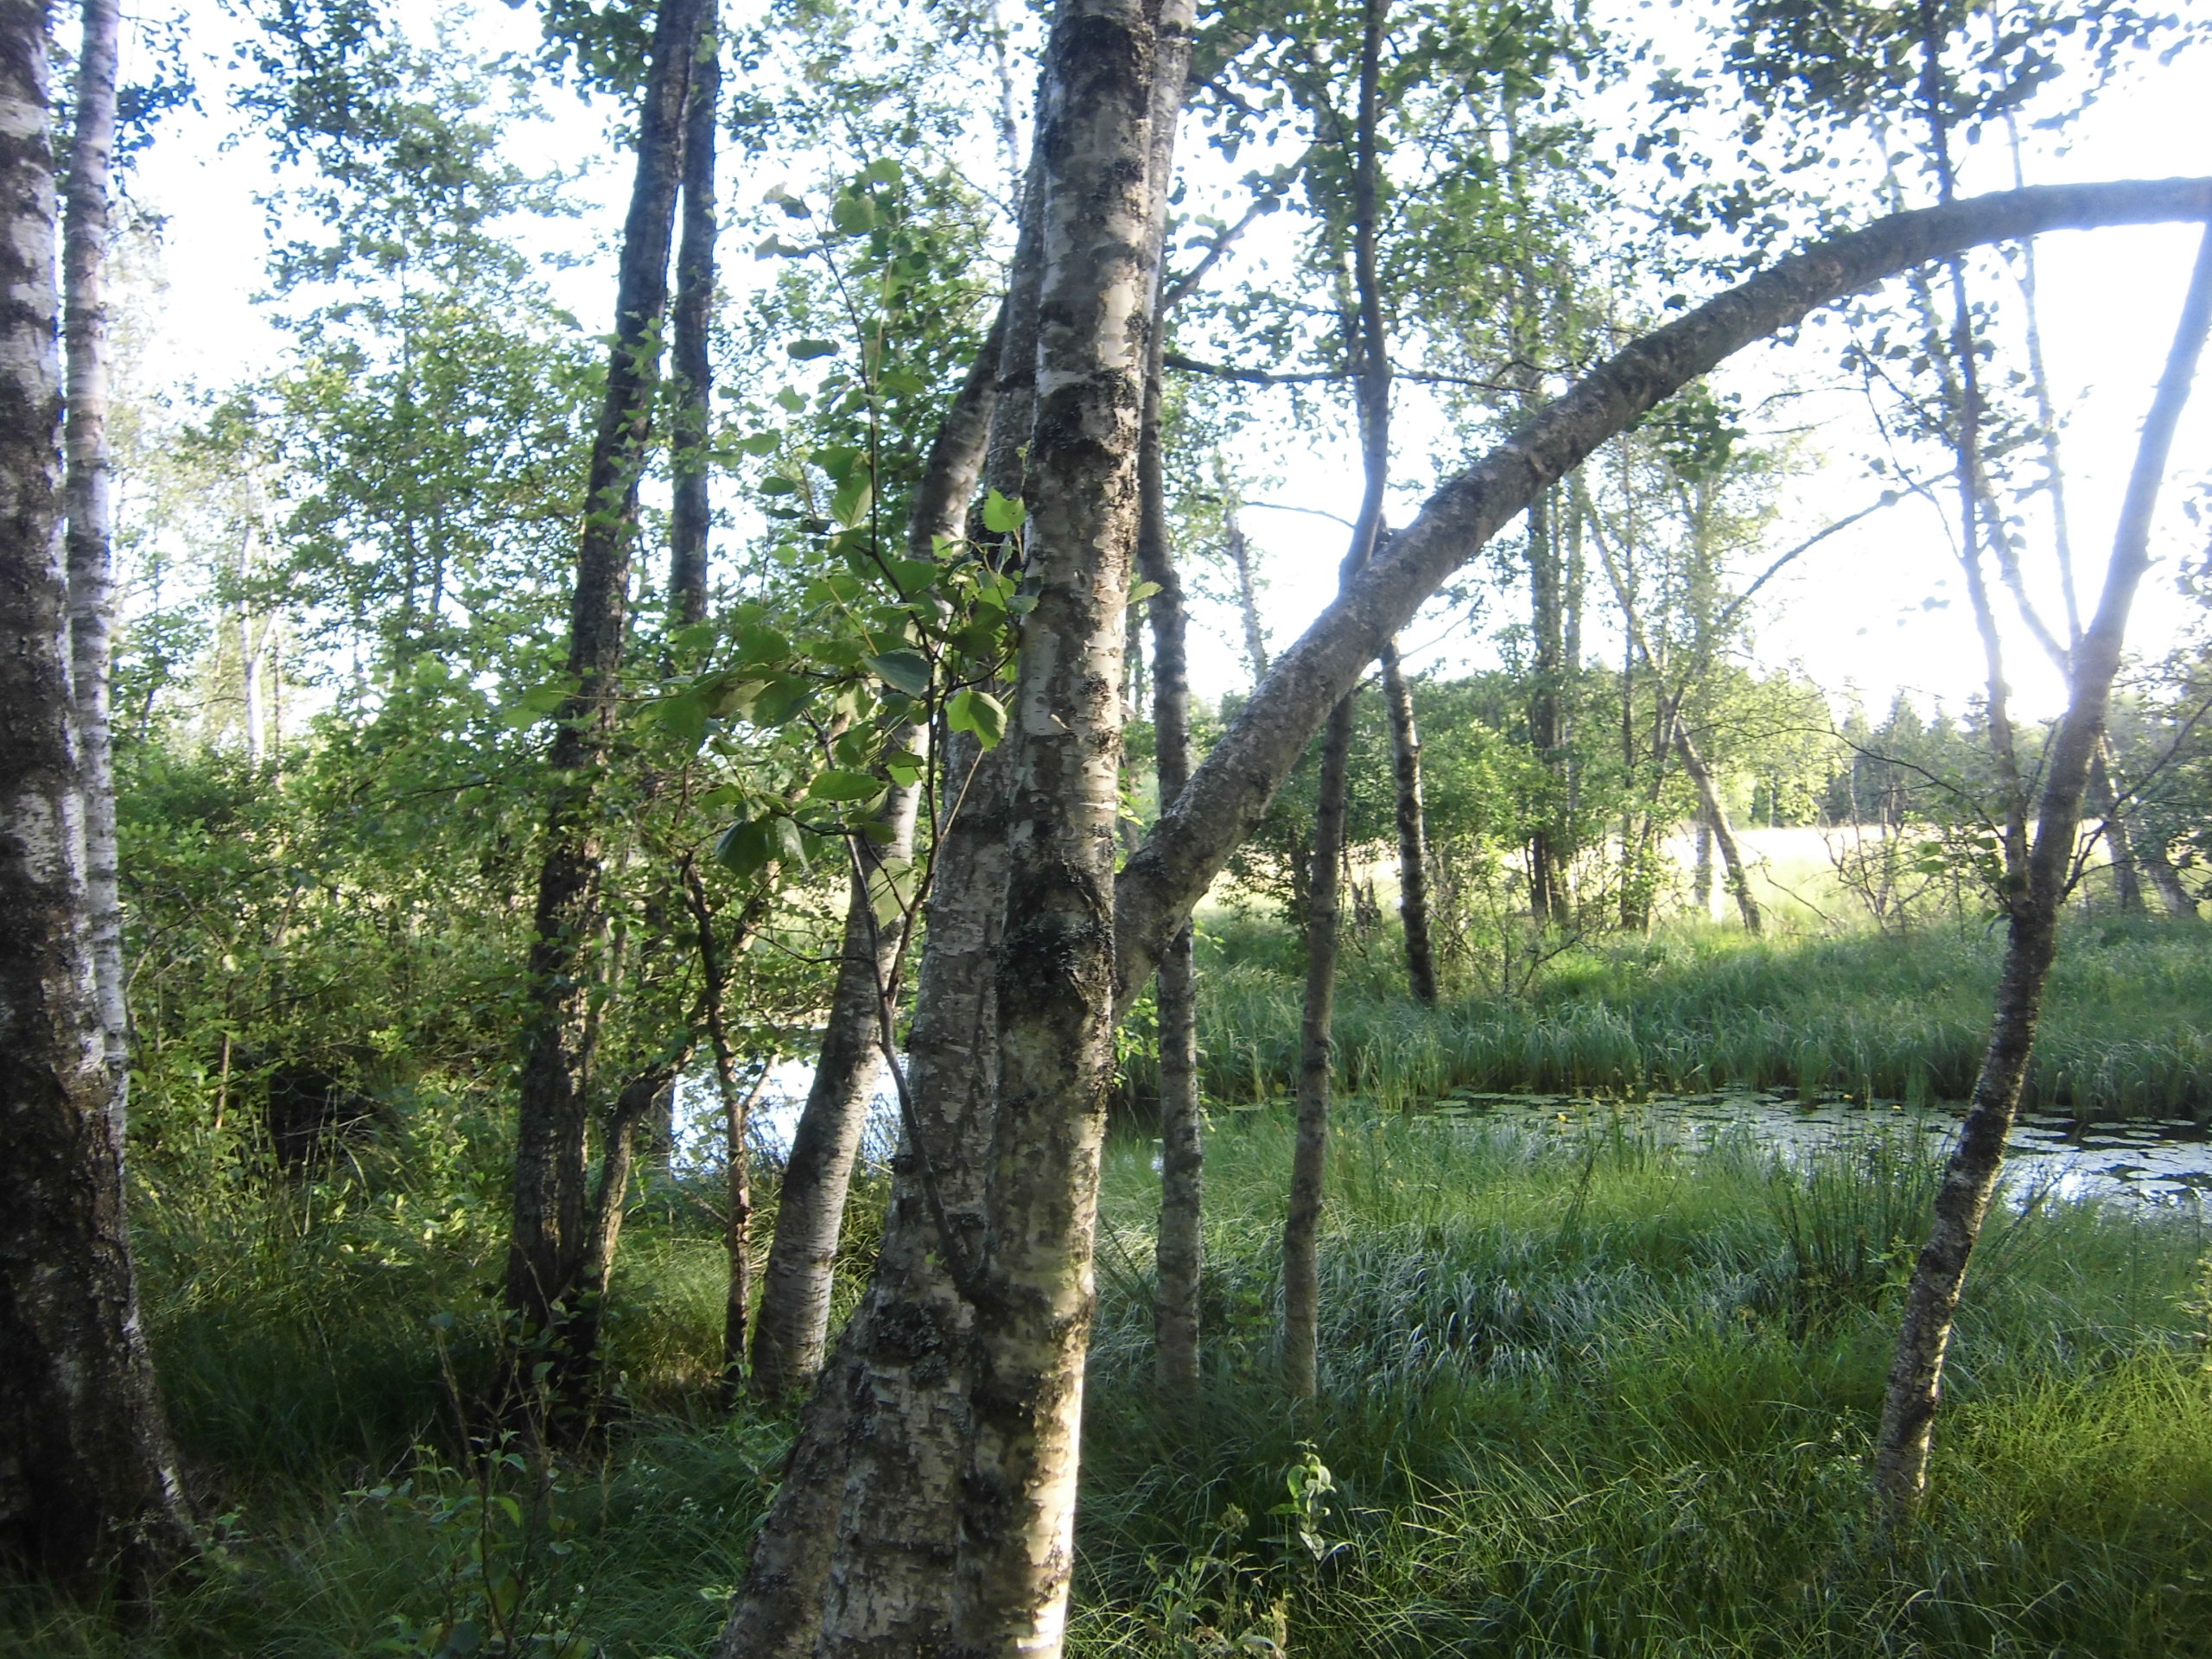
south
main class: Woodland
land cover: Pine dominated mixed woodland
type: boreal forest
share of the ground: 50 - 75 %
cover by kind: broadleaved forest trees 35 %, herbaceous plants 35 %, coniferous forest trees 25 %, shrubs 5 %
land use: Forestry
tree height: > 5 m
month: July
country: SE
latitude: 57.2464
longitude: 15.3832
